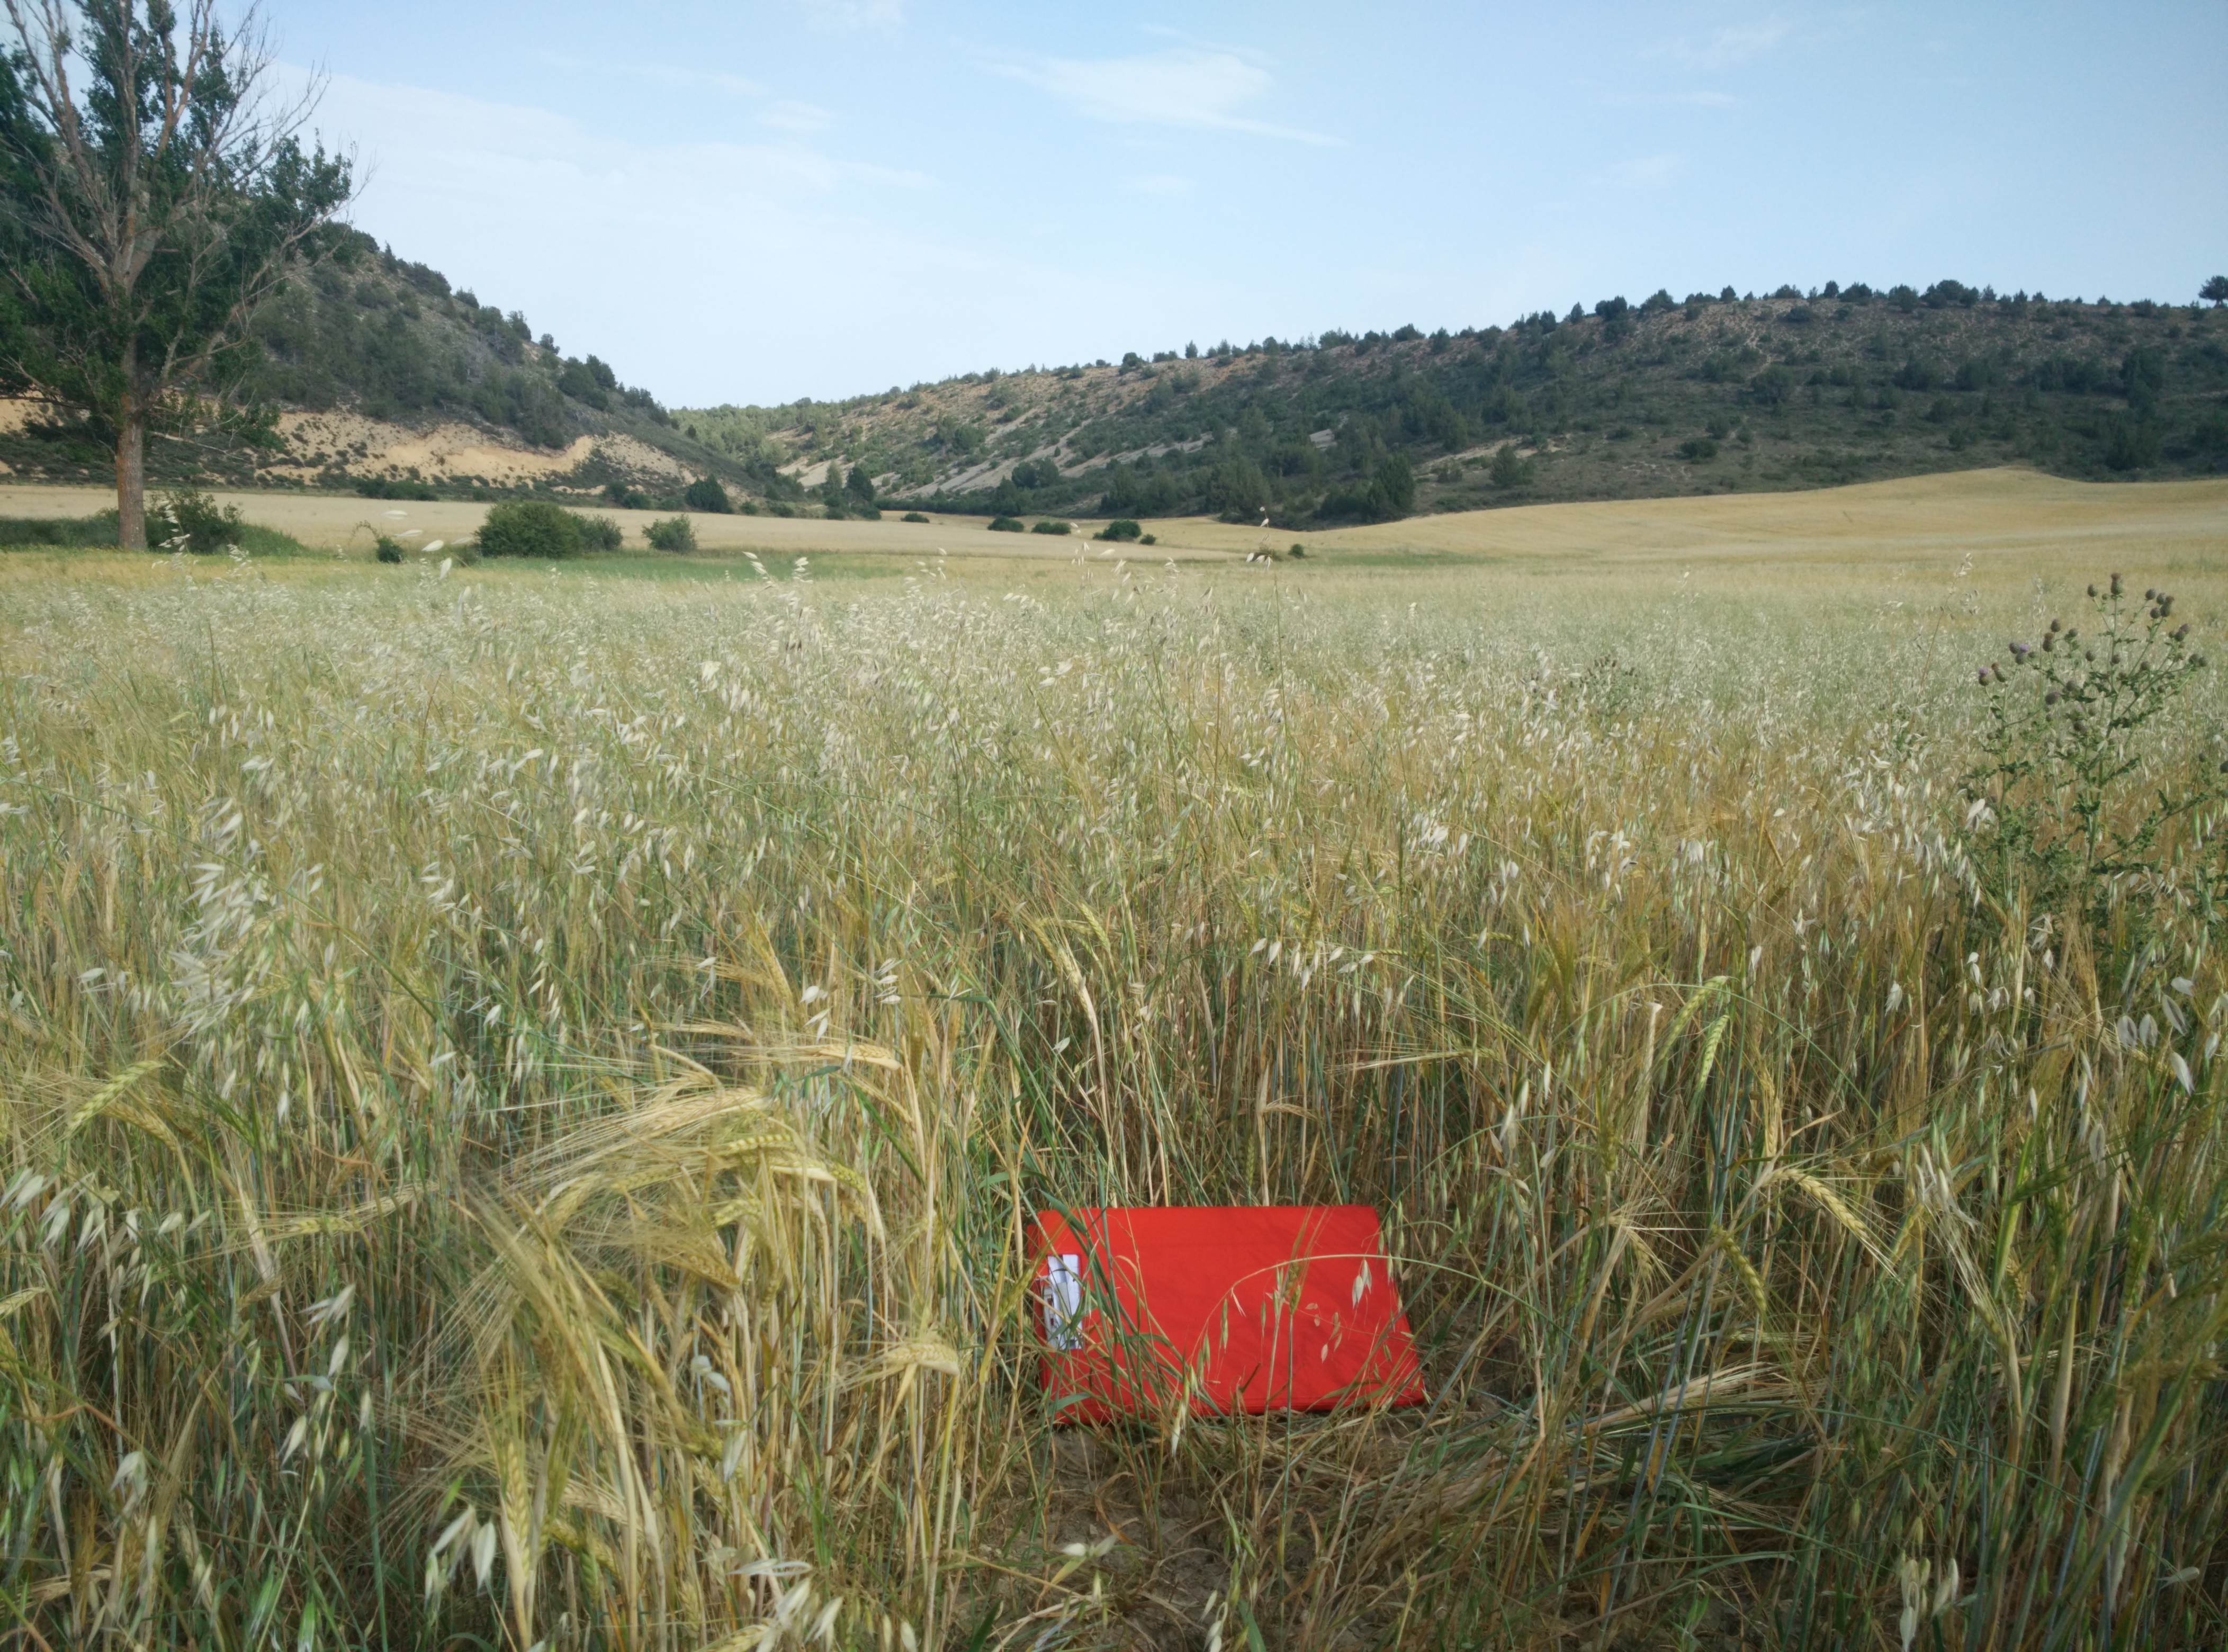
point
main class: Cropland
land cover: Barley
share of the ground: > 75 %
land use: Agriculture (excluding fallow land and kitchen gardens)
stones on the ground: 25 - 50 %
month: July
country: ES
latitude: 41.0288
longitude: -2.1223
